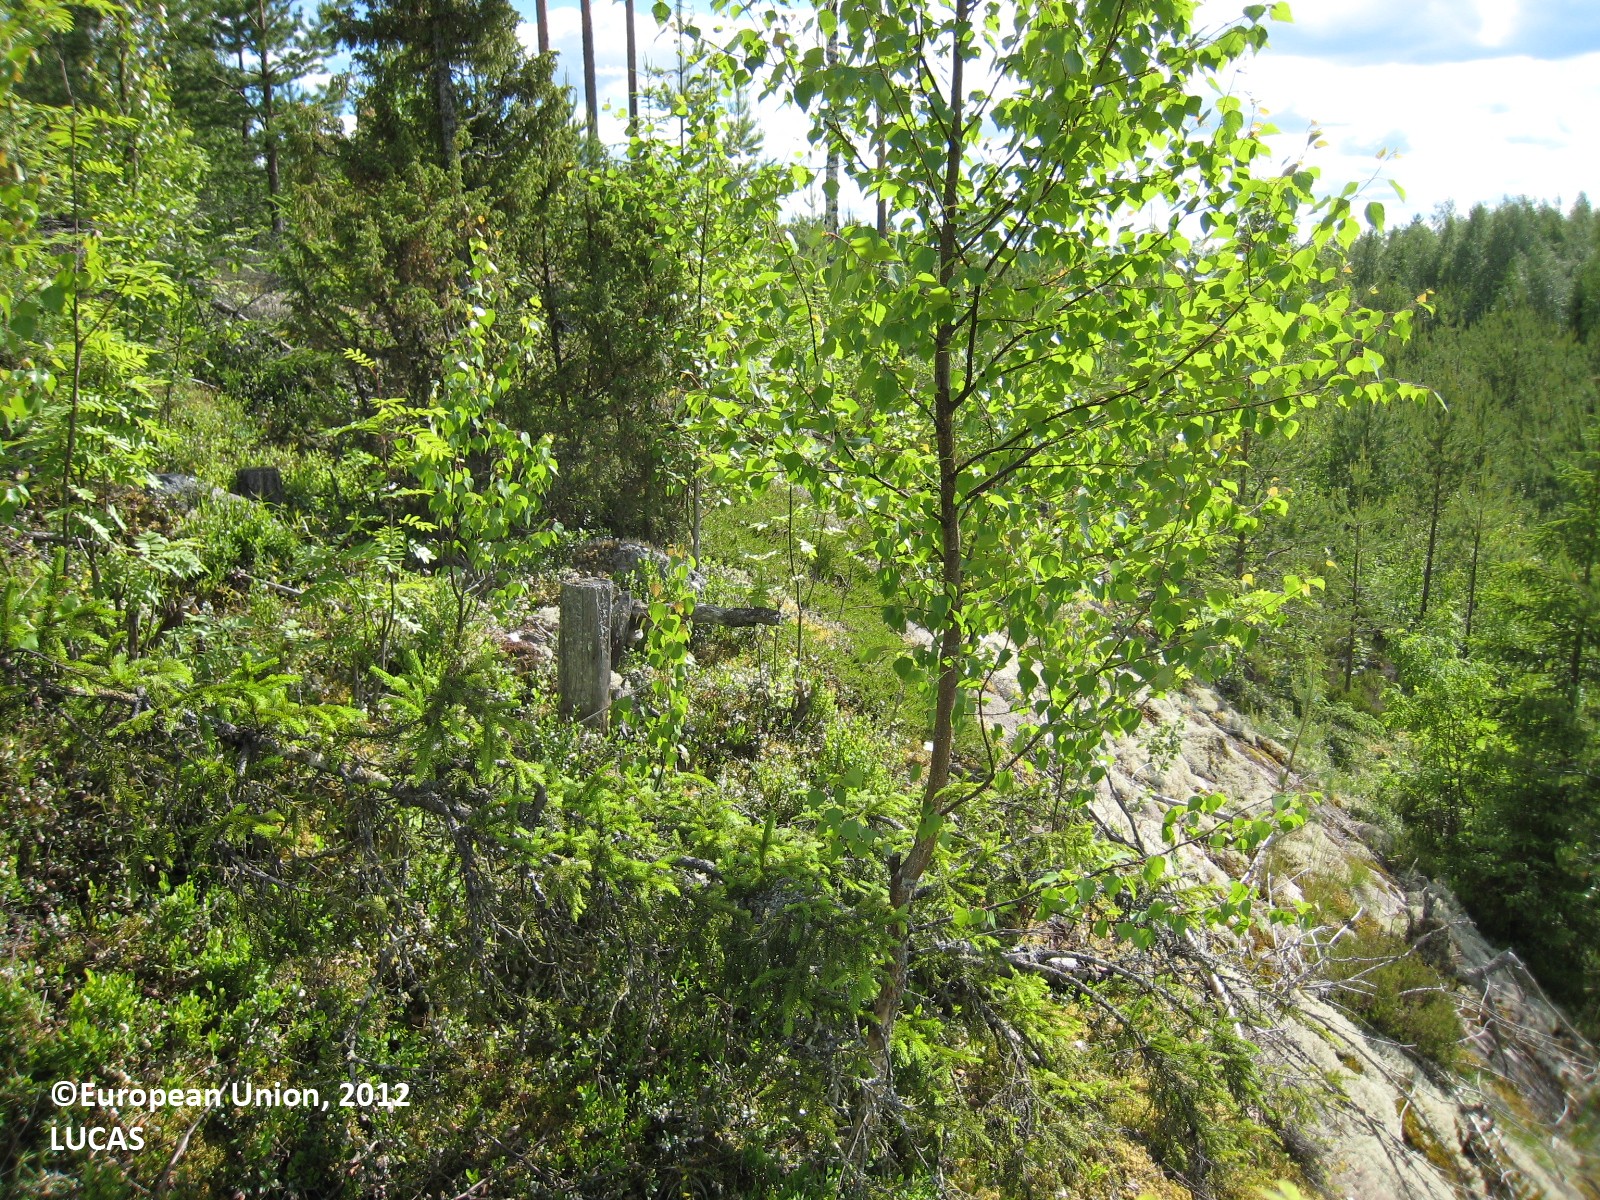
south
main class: Woodland
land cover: Pine dominated mixed woodland
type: boreal forest
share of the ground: 50 - 75 %
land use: Forestry
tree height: > 5 m
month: June
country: FI
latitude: 62.1691
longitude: 26.2035
